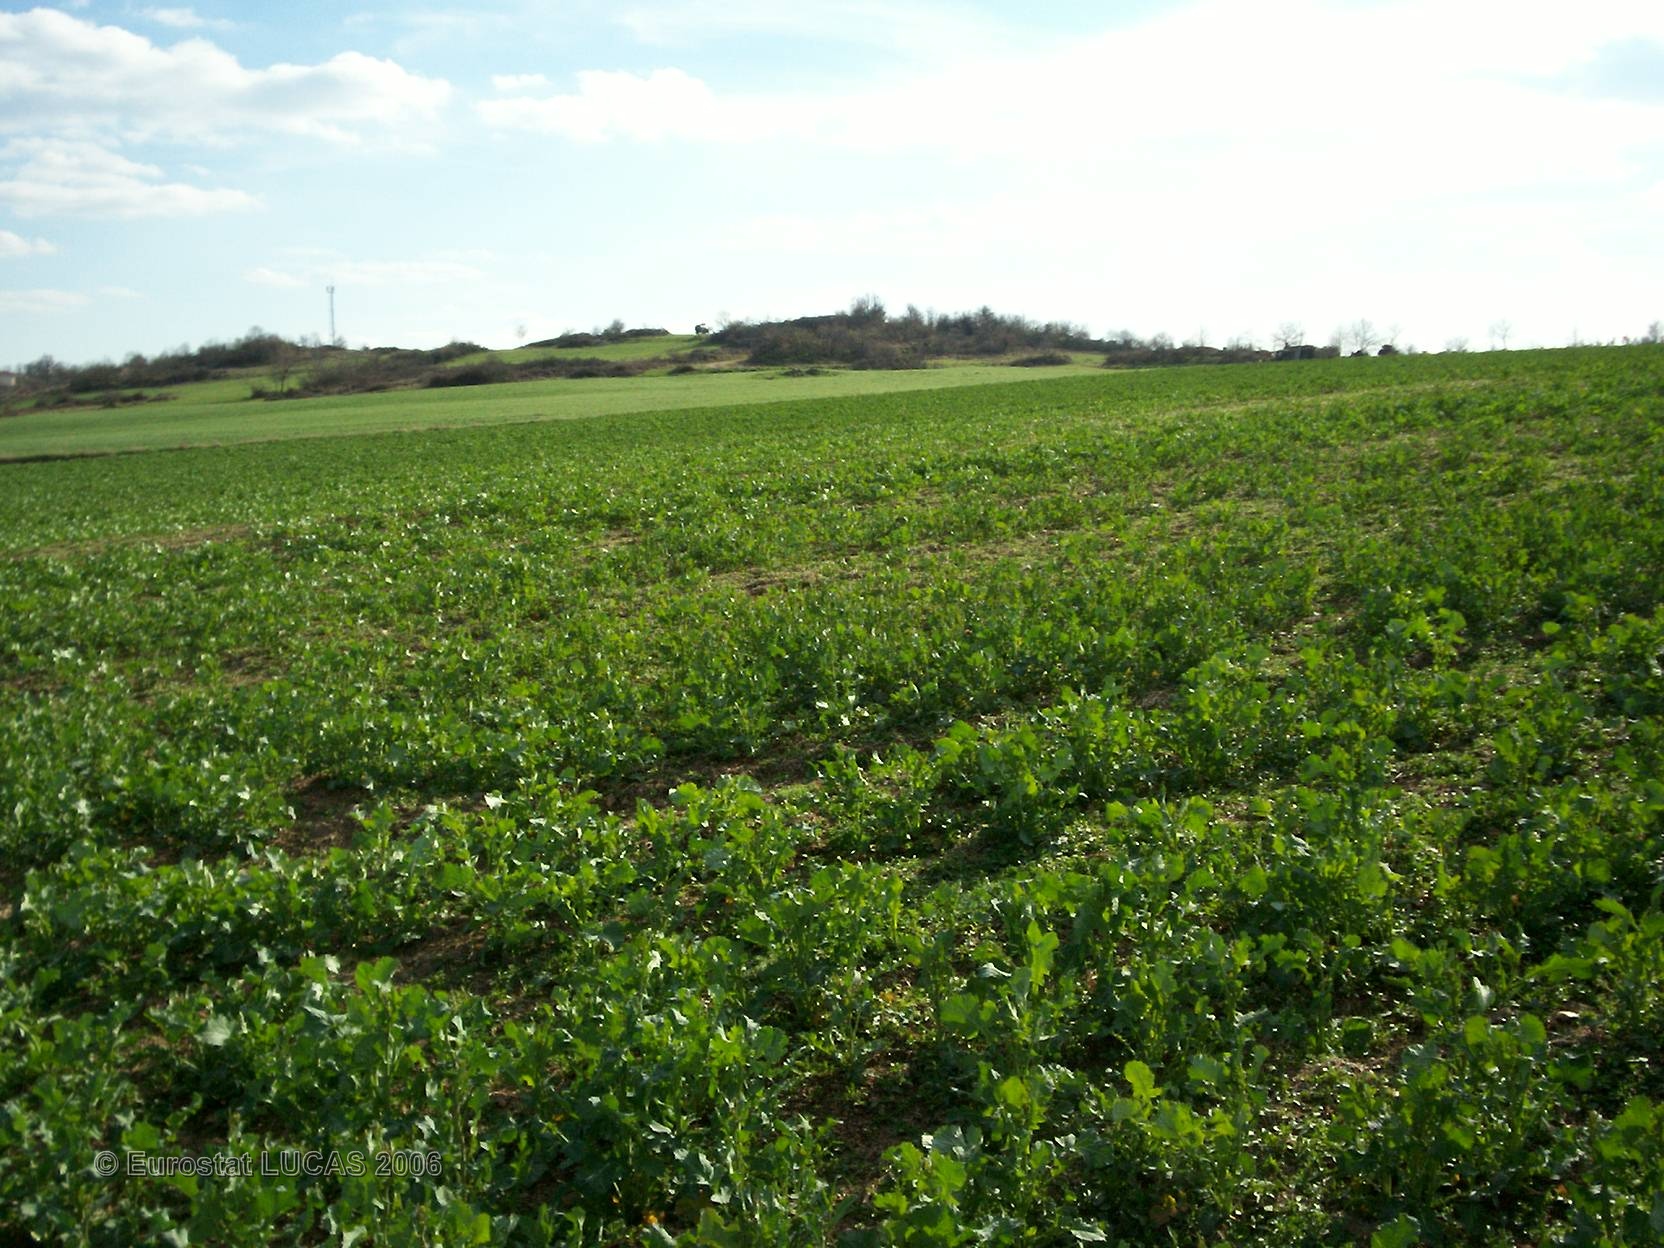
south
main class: Cropland
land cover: Rape and turnip rape
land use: Agriculture (excluding fallow land and kitchen gardens)
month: April
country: FR
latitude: 45.3442
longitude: 3.2759
